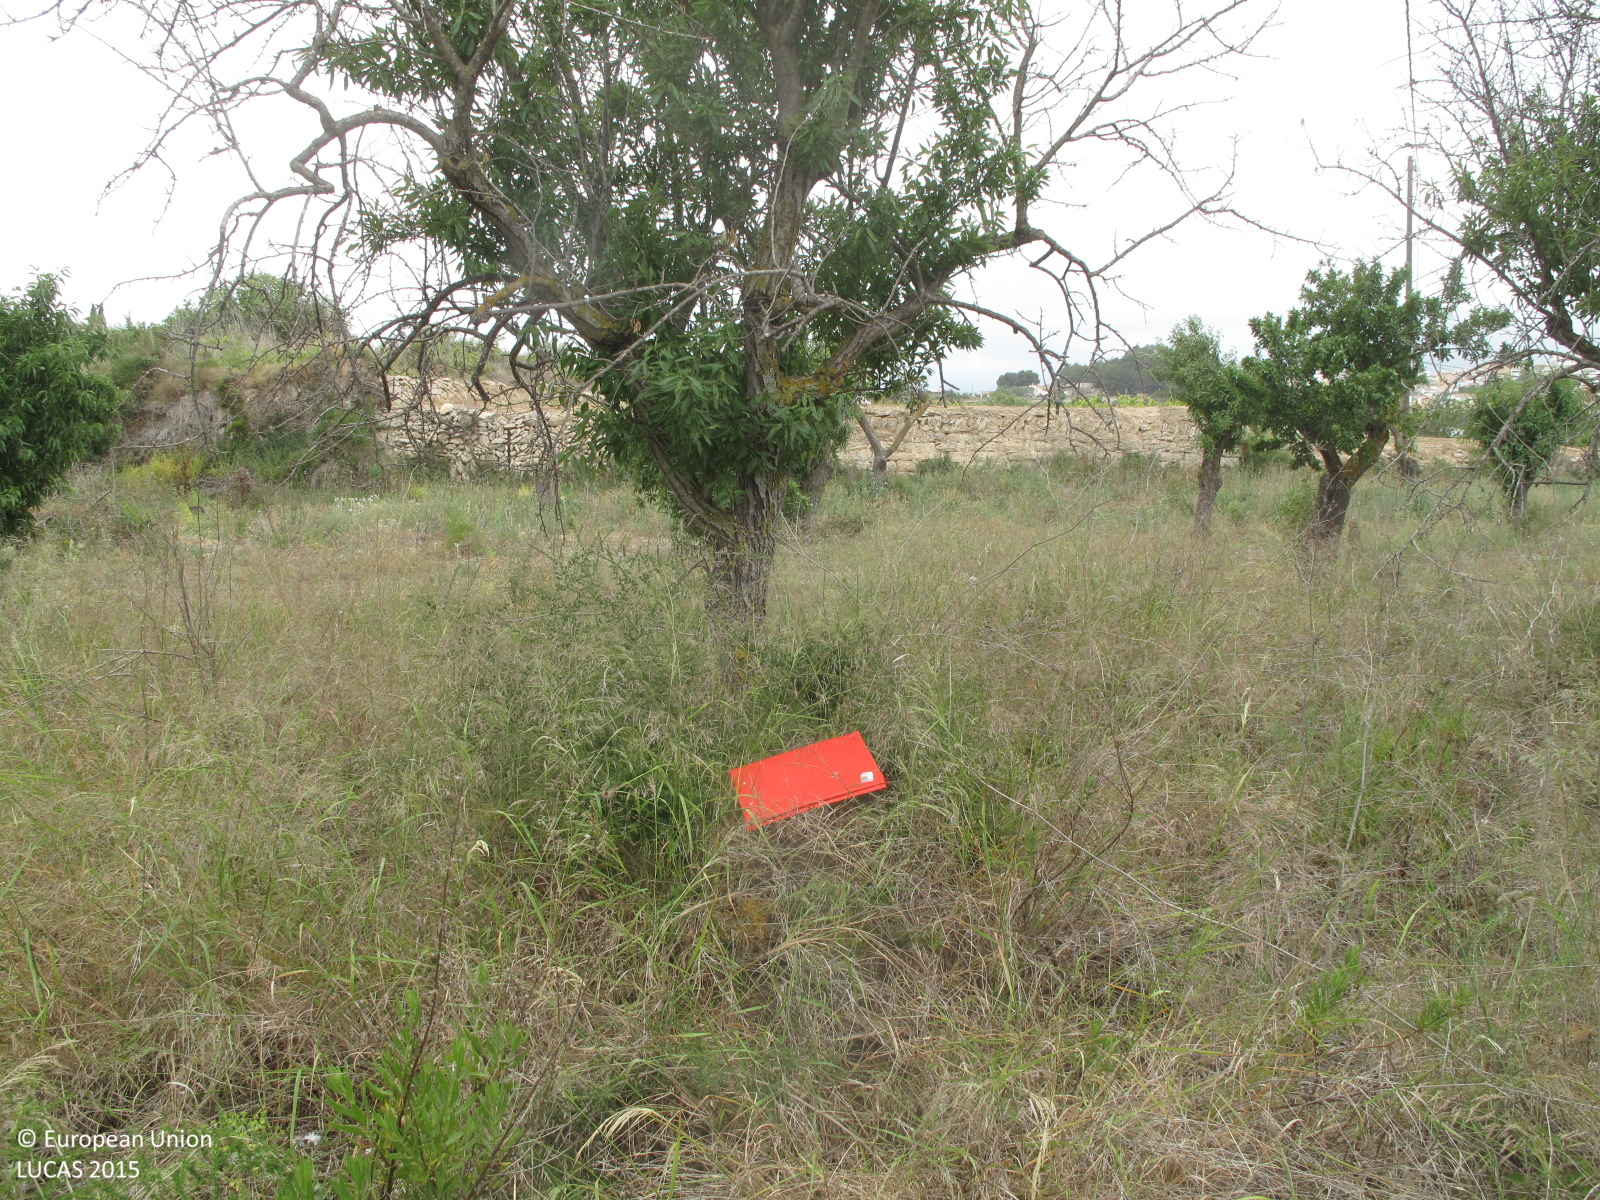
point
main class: Cropland
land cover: Nuts trees
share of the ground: 10 - 25 %
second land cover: Shrubland without tree cover
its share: 25 - 50 %
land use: Abandoned areas
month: May
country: ES
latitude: 38.7319
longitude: 0.1540
